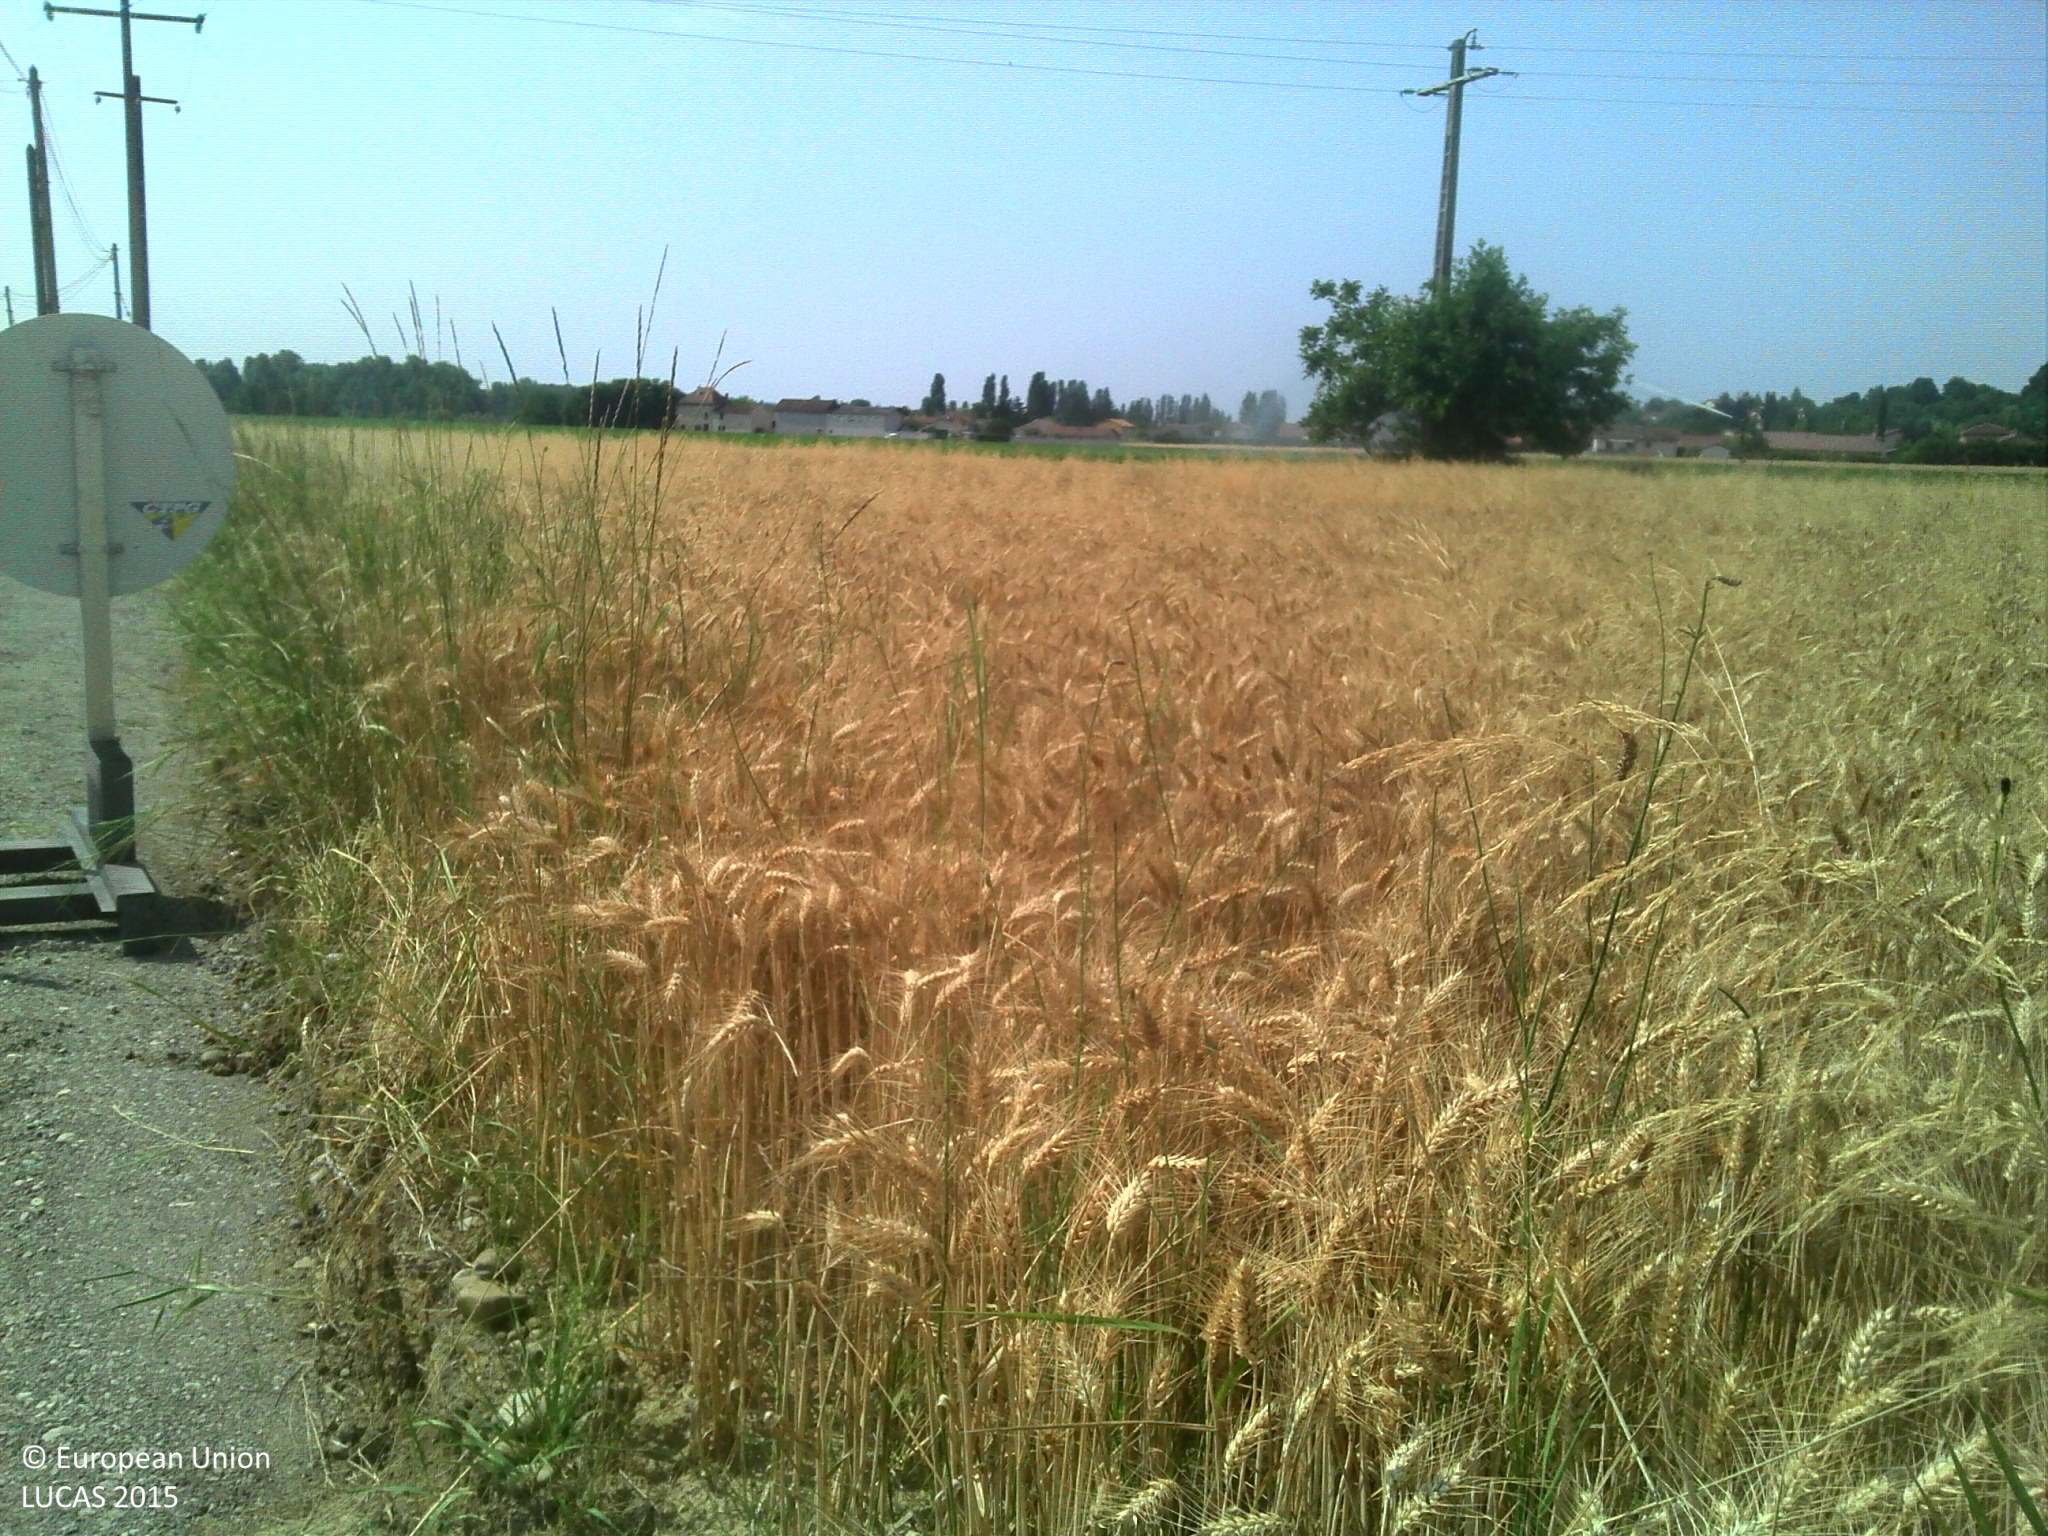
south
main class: Cropland
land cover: Durum wheat
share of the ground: > 75 %
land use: Agriculture (excluding fallow land and kitchen gardens)
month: July
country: FR
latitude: 45.7735
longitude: 5.1813
